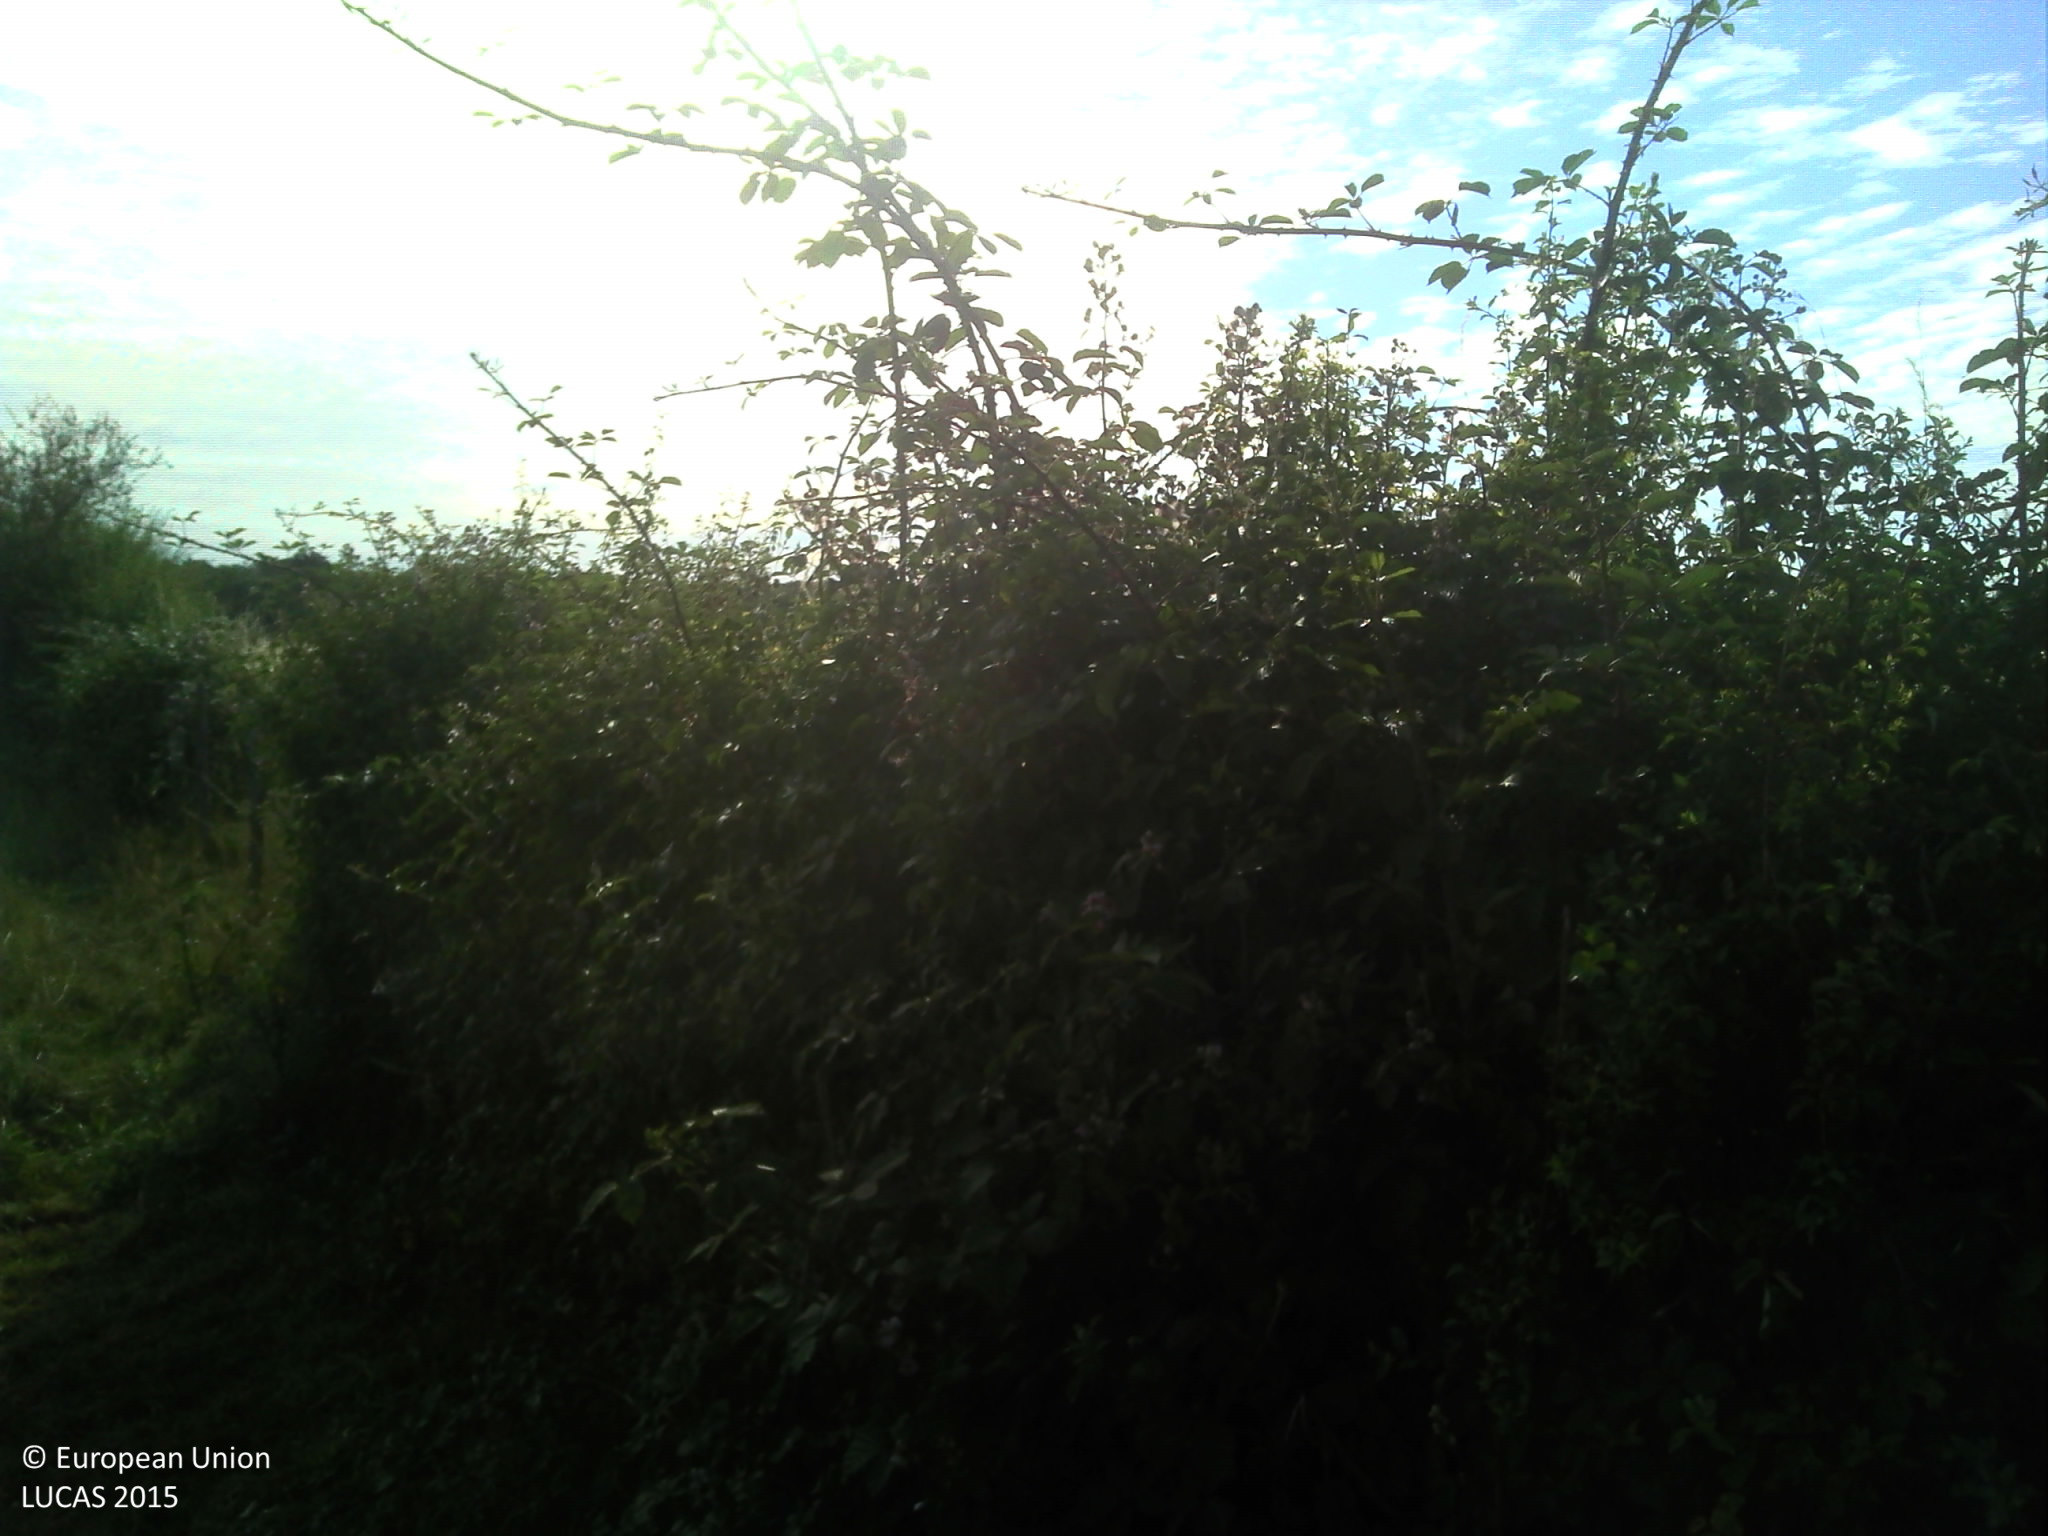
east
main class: Grassland
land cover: Grassland without tree/shrub cover
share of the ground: > 75 %
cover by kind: herbaceous plants 100 %
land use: Agriculture (excluding fallow land and kitchen gardens)
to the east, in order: Grassland without tree/shrub cover; Fences; Abandoned hedges; Tracks; Common wheat
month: June
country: FR
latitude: 46.7303
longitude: 4.8064
